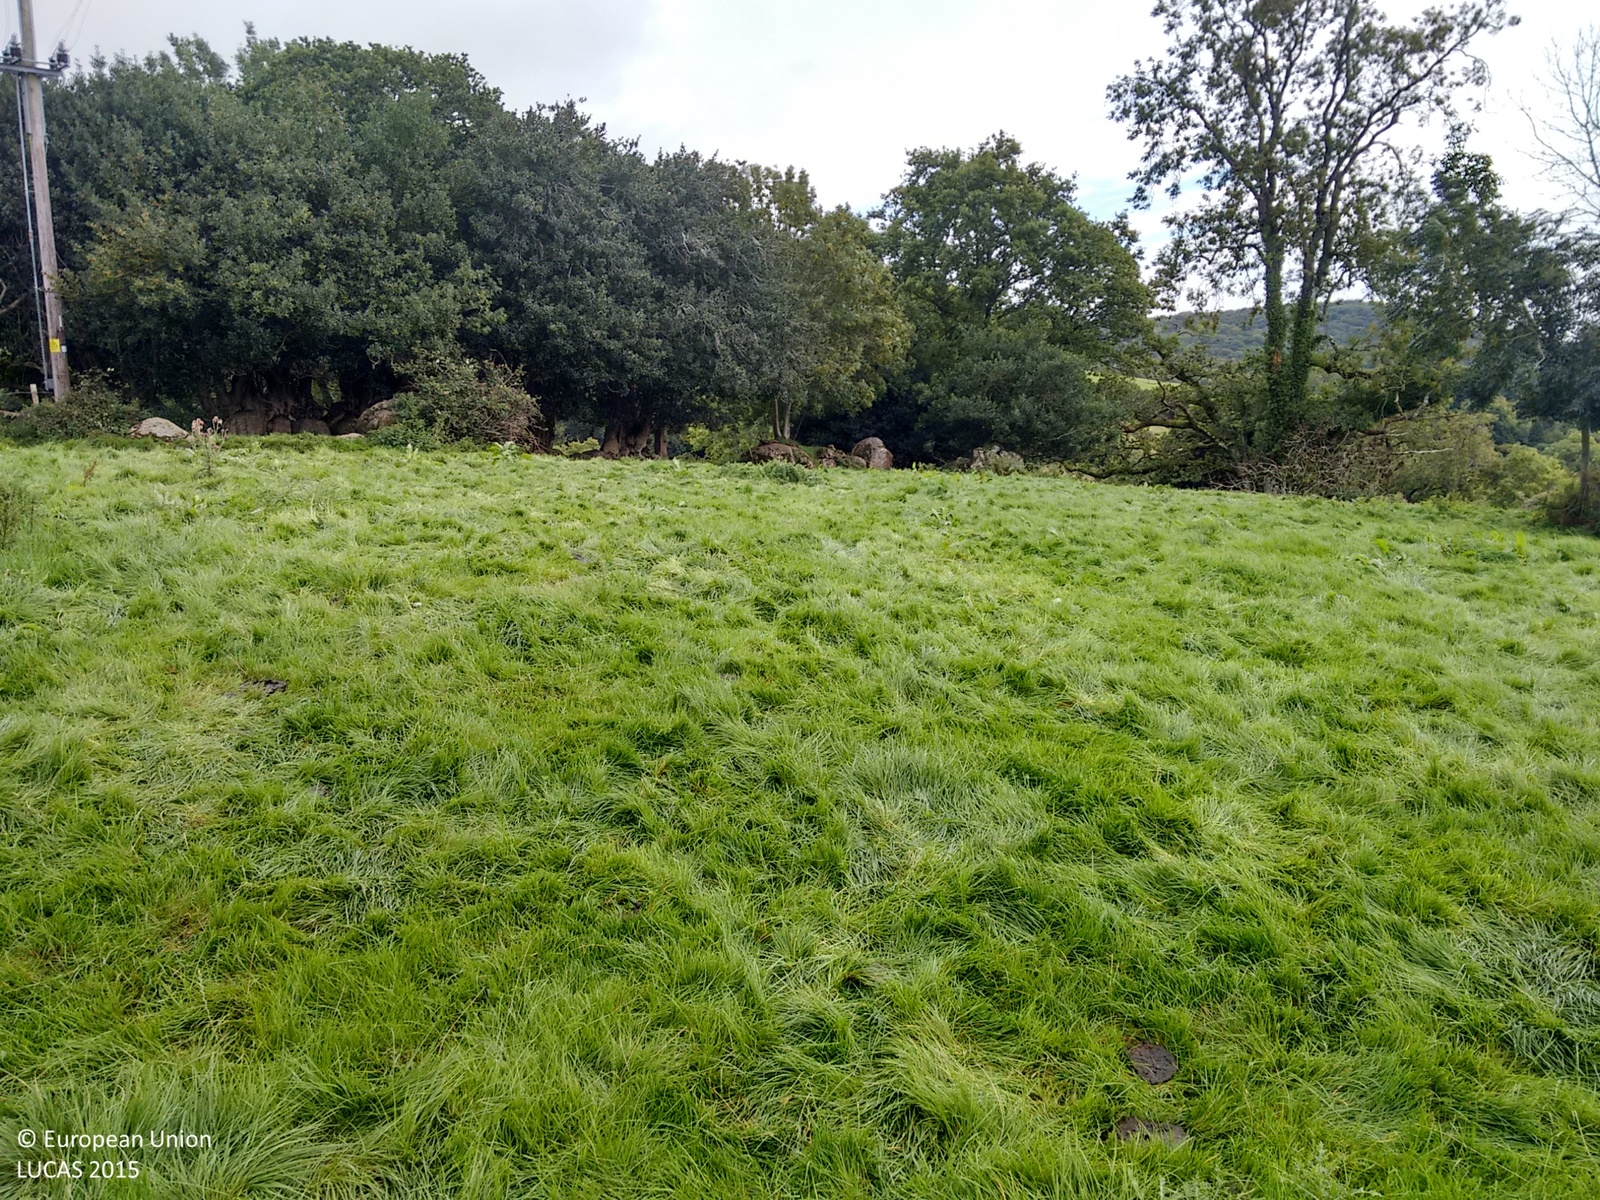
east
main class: Grassland
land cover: Grassland without tree/shrub cover
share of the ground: > 75 %
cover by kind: herbaceous plants 100 %
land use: Agriculture (excluding fallow land and kitchen gardens)
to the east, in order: Grassland without tree/shrub cover; Groves; Grassland without tree/shrub cover; Single bushes/trees; Grassland without tree/shrub cover; Rivers and streams; Fences; Abandoned hedges; Grass margins; Paved roads, cycling and walking lanes; Electric lines; Dry stone walls; Grassland without tree/shrub cover; Fences; Broadleaved woodland
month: September
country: GB
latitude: 50.6115
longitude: -3.6965
